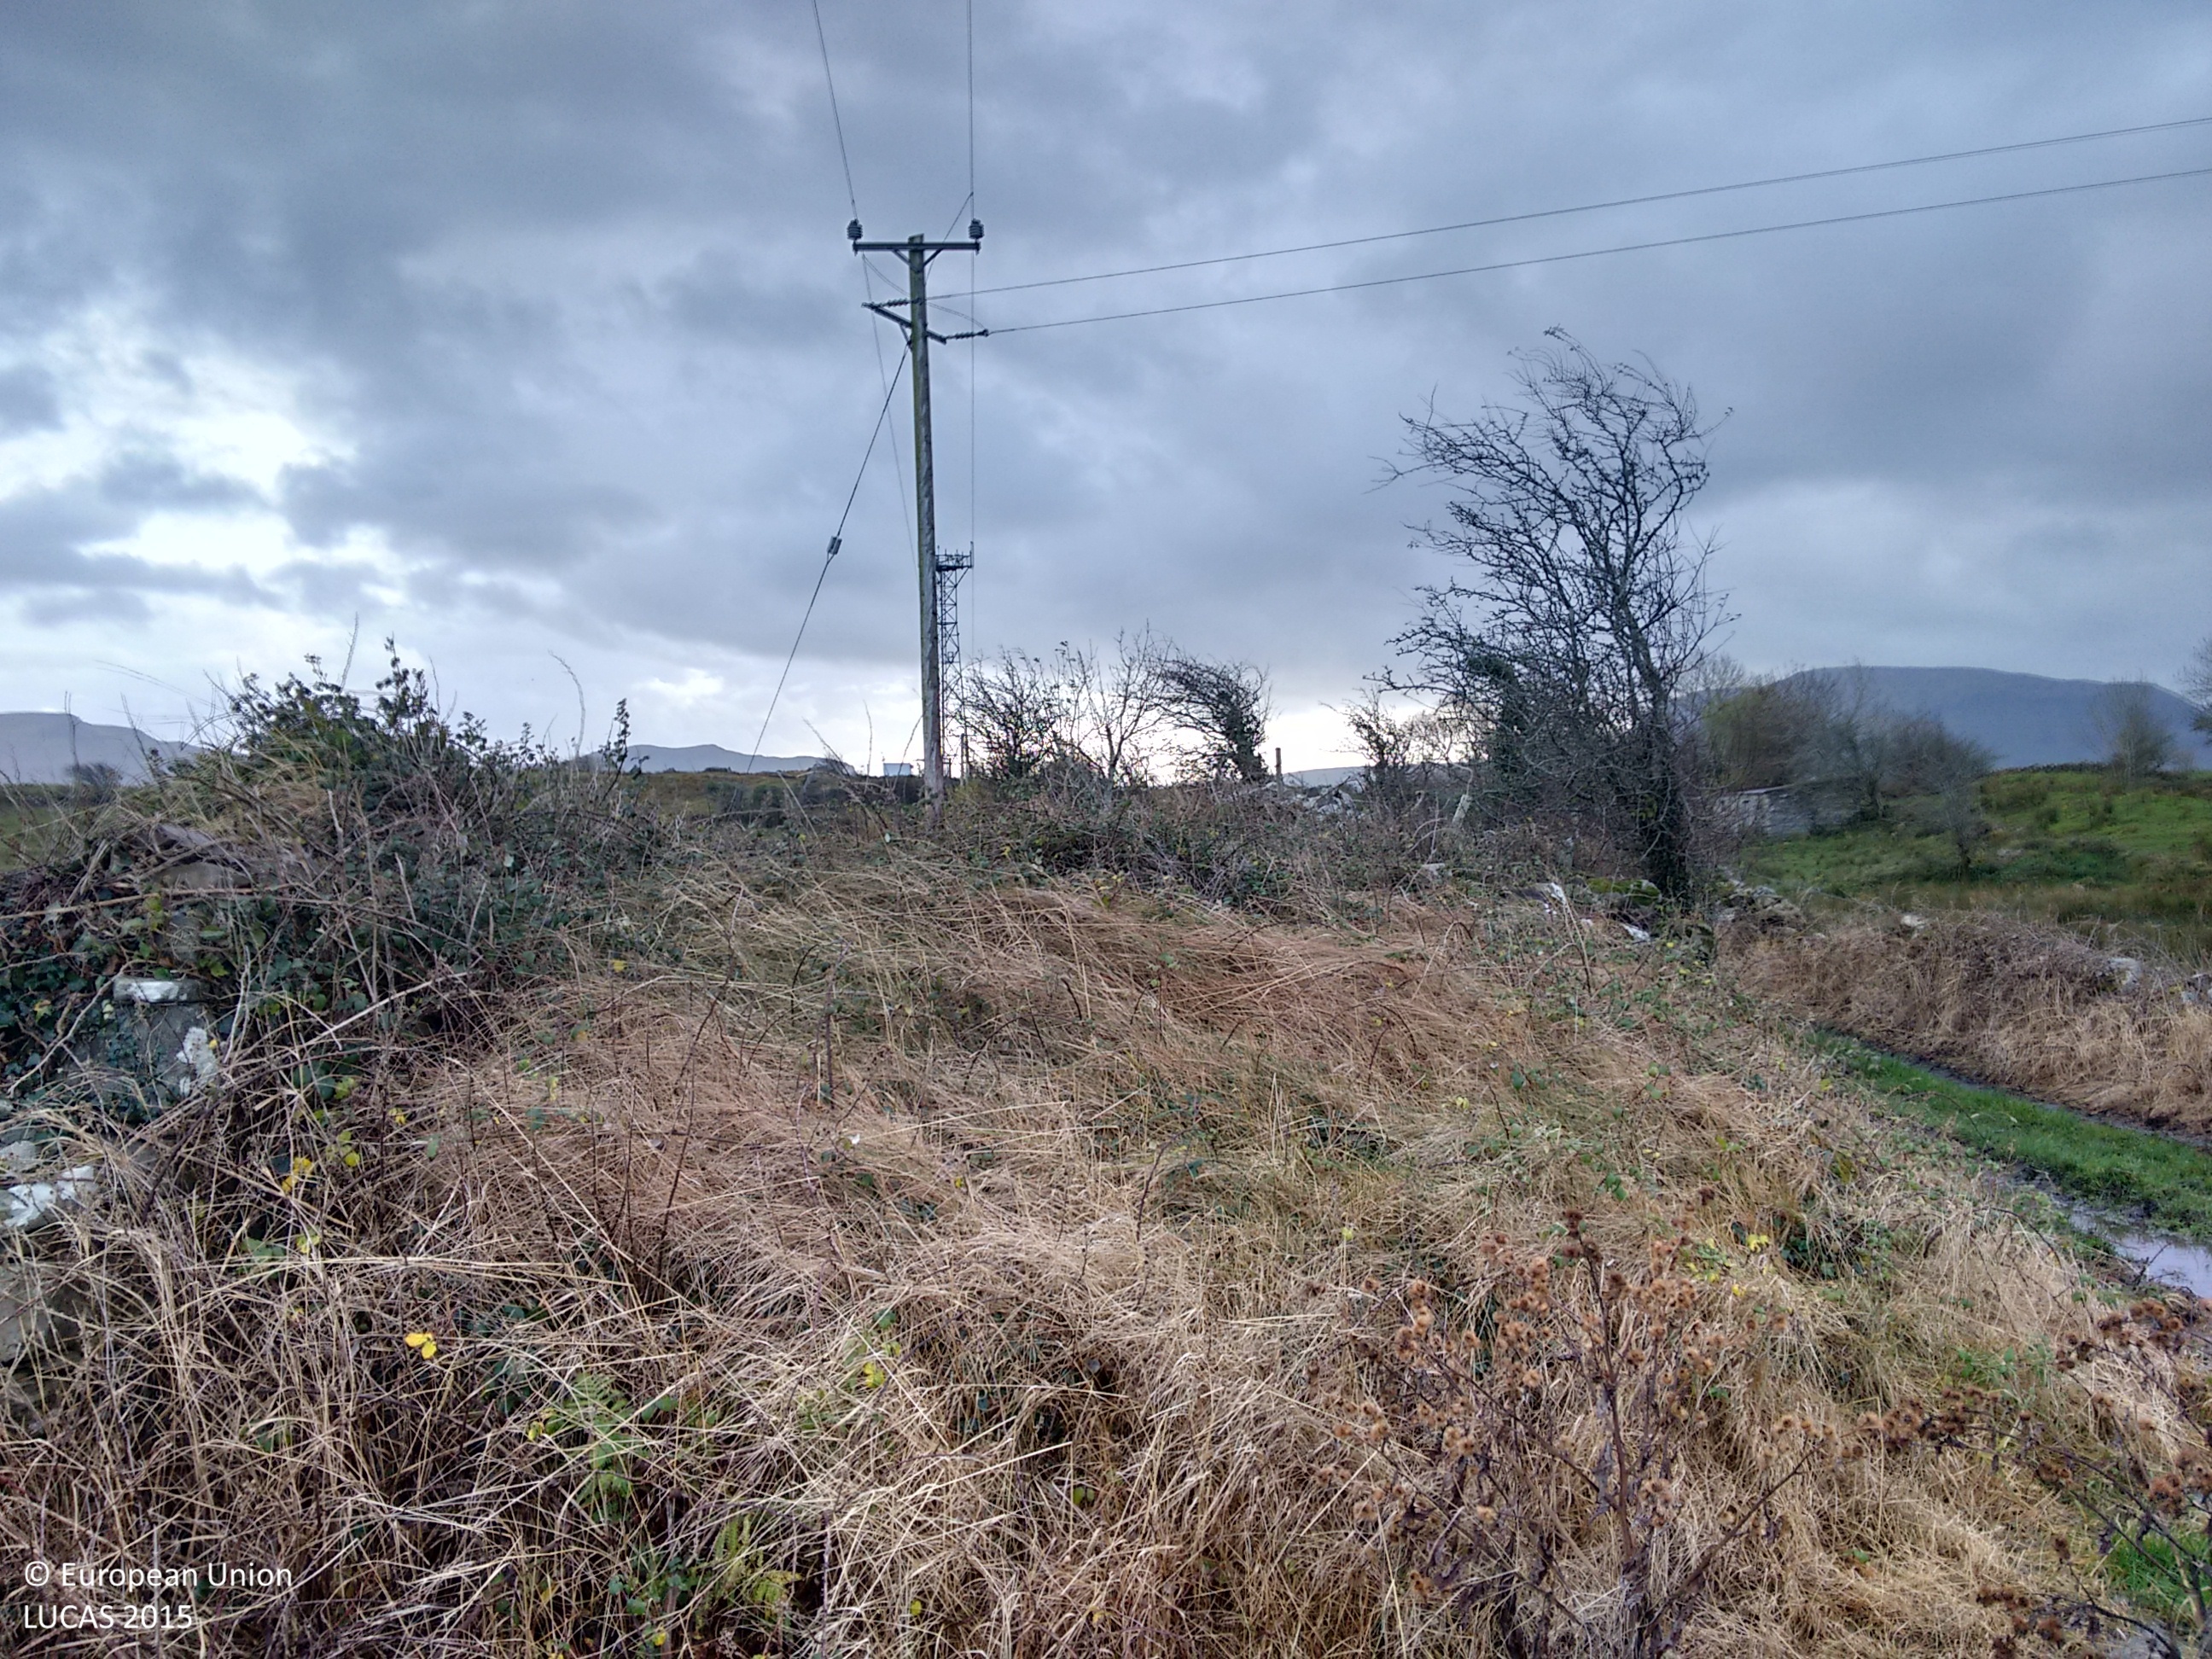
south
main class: Grassland
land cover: Grassland without tree/shrub cover
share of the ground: > 75 %
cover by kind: herbaceous plants 100 %
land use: Agriculture (excluding fallow land and kitchen gardens)
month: November
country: IE
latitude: 54.4590
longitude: -8.3417
